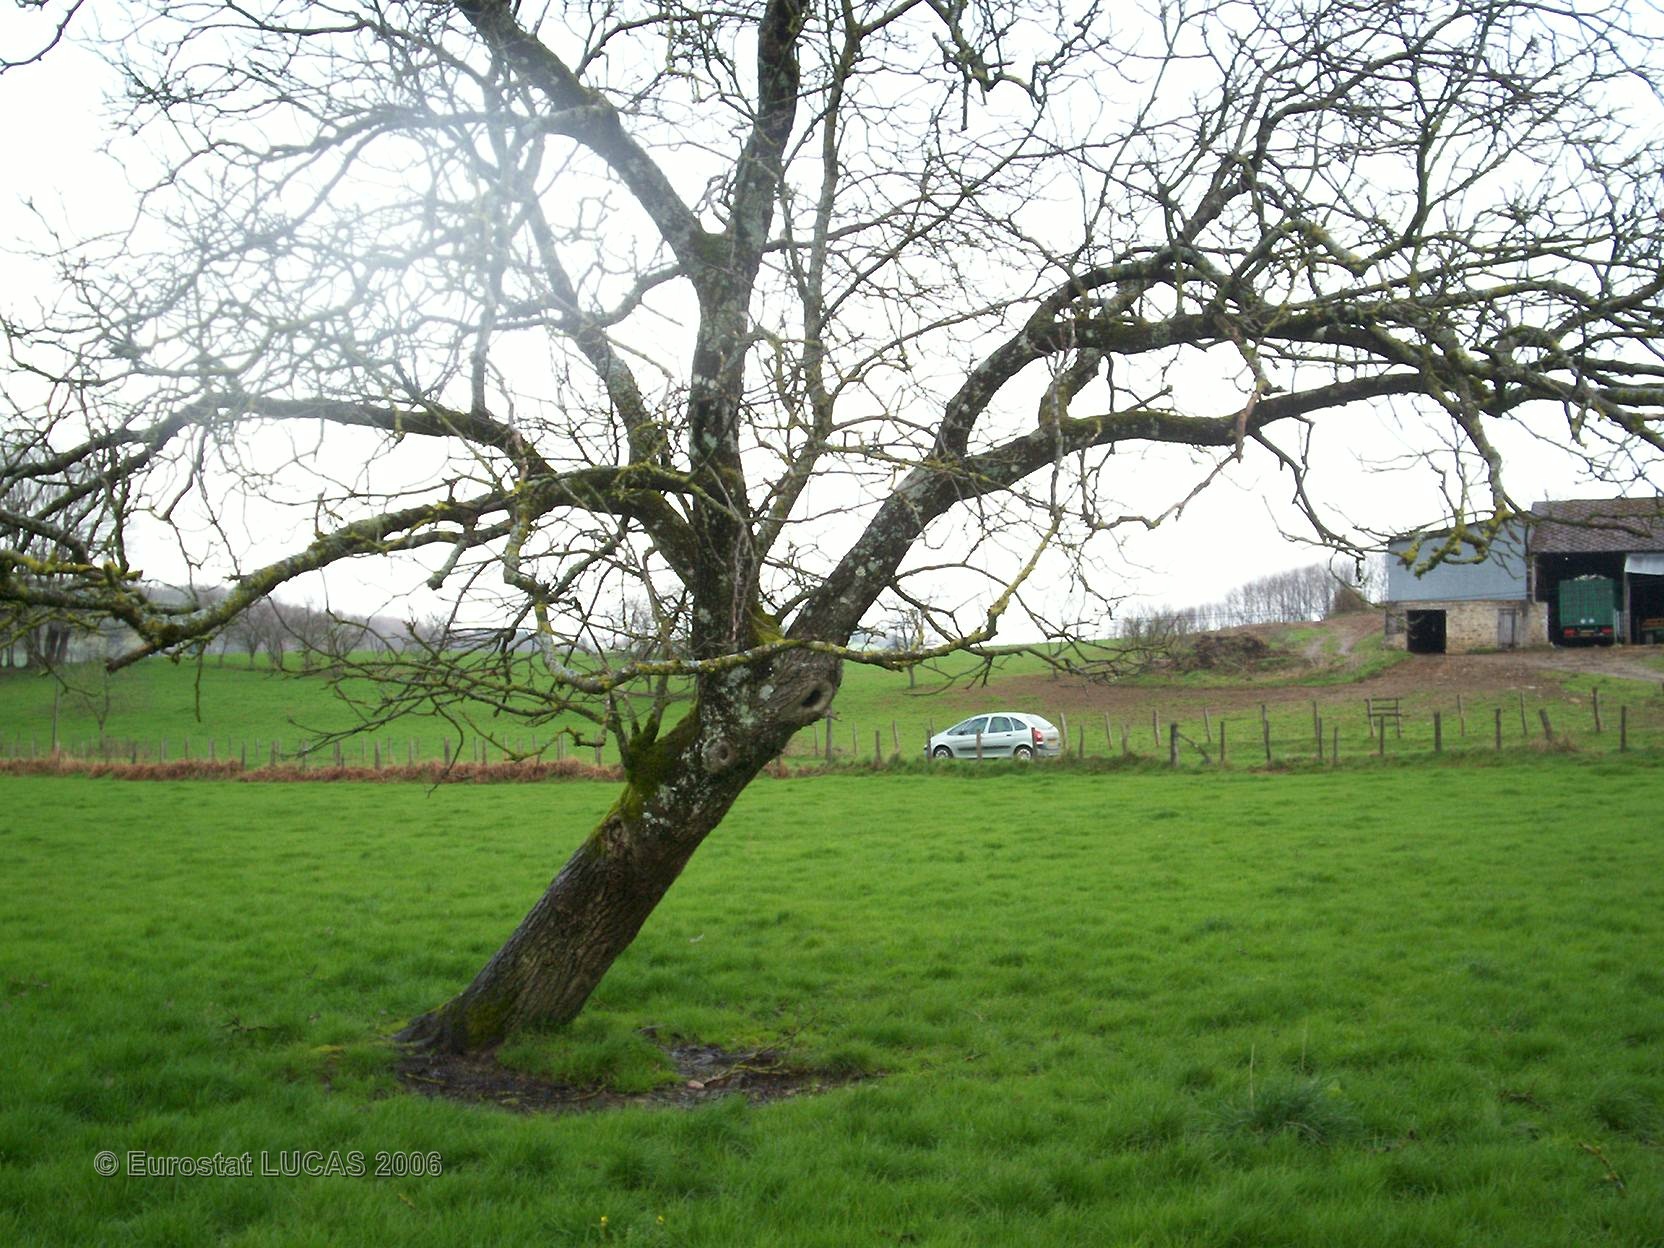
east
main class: Grassland
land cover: Grassland with sparse tree/shrub cover
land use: Agriculture (excluding fallow land and kitchen gardens)
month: April
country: FR
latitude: 45.5678
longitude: 1.6014
